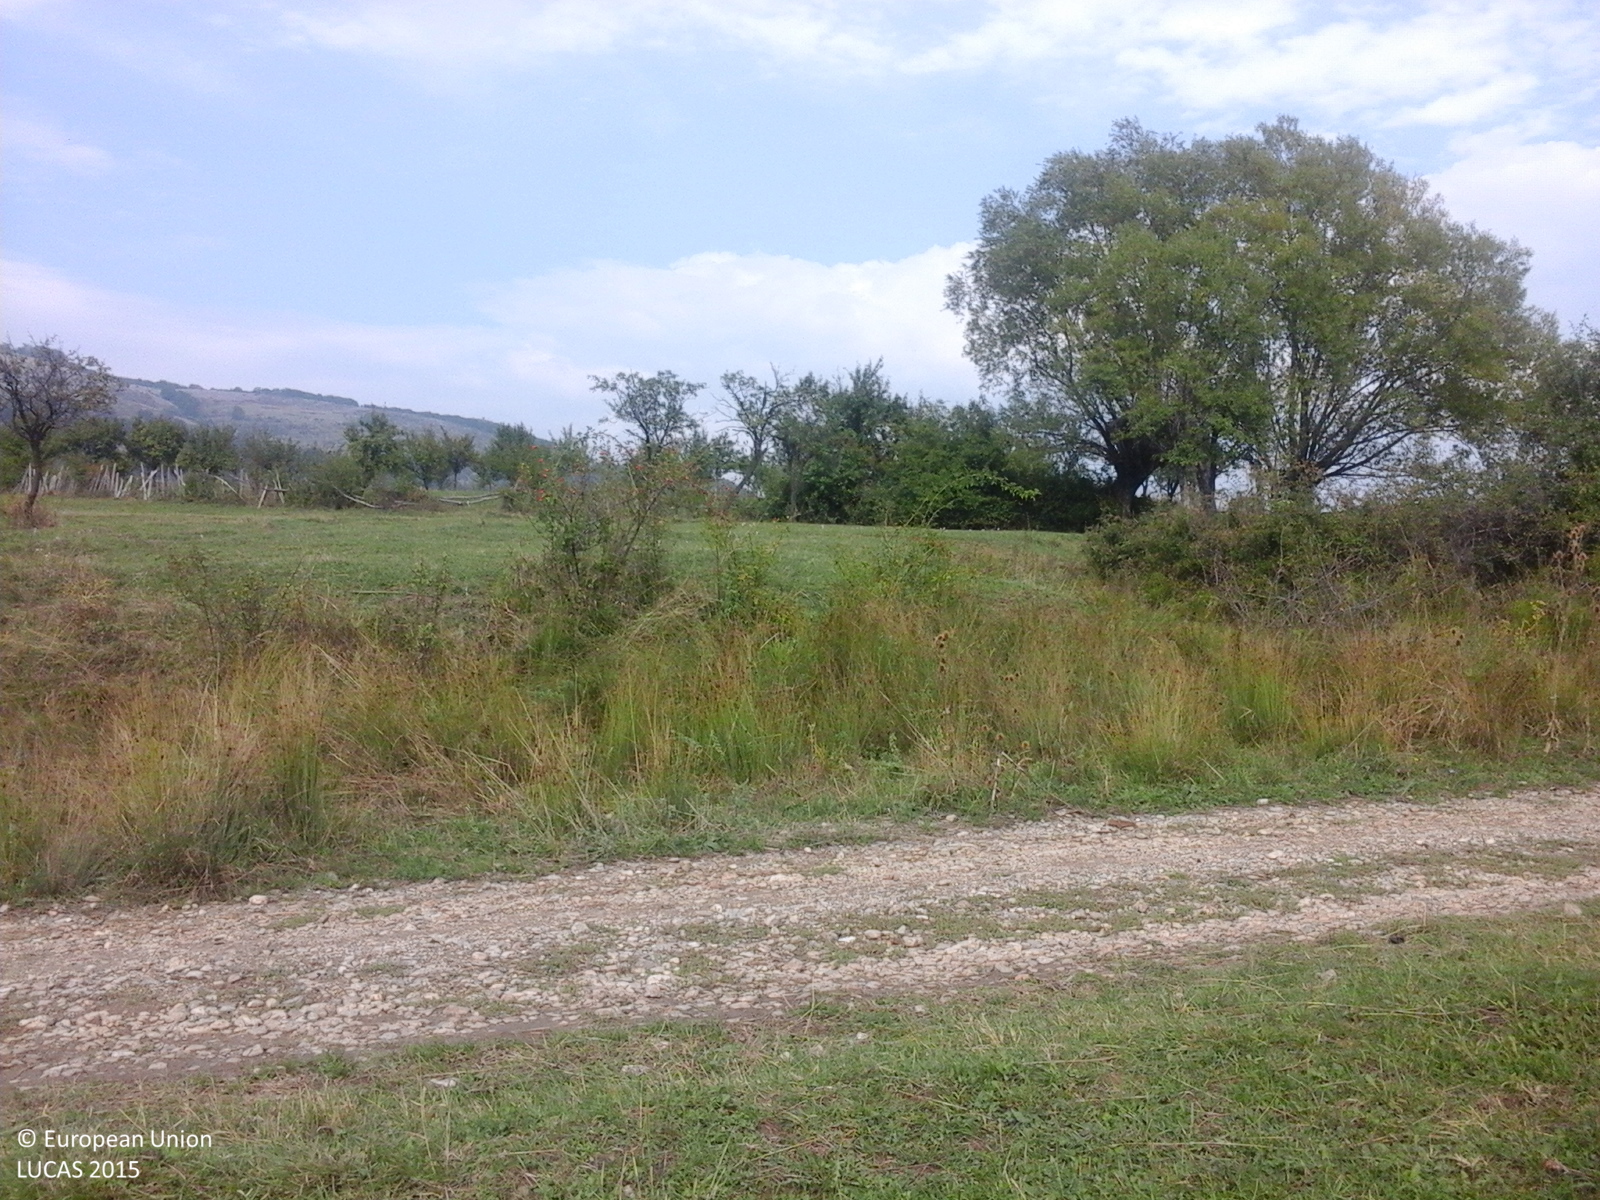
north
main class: Grassland
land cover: Grassland without tree/shrub cover
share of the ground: > 75 %
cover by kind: herbaceous plants 100 %
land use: Agriculture (excluding fallow land and kitchen gardens)
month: September
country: RO
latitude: 45.1582
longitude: 23.2459
